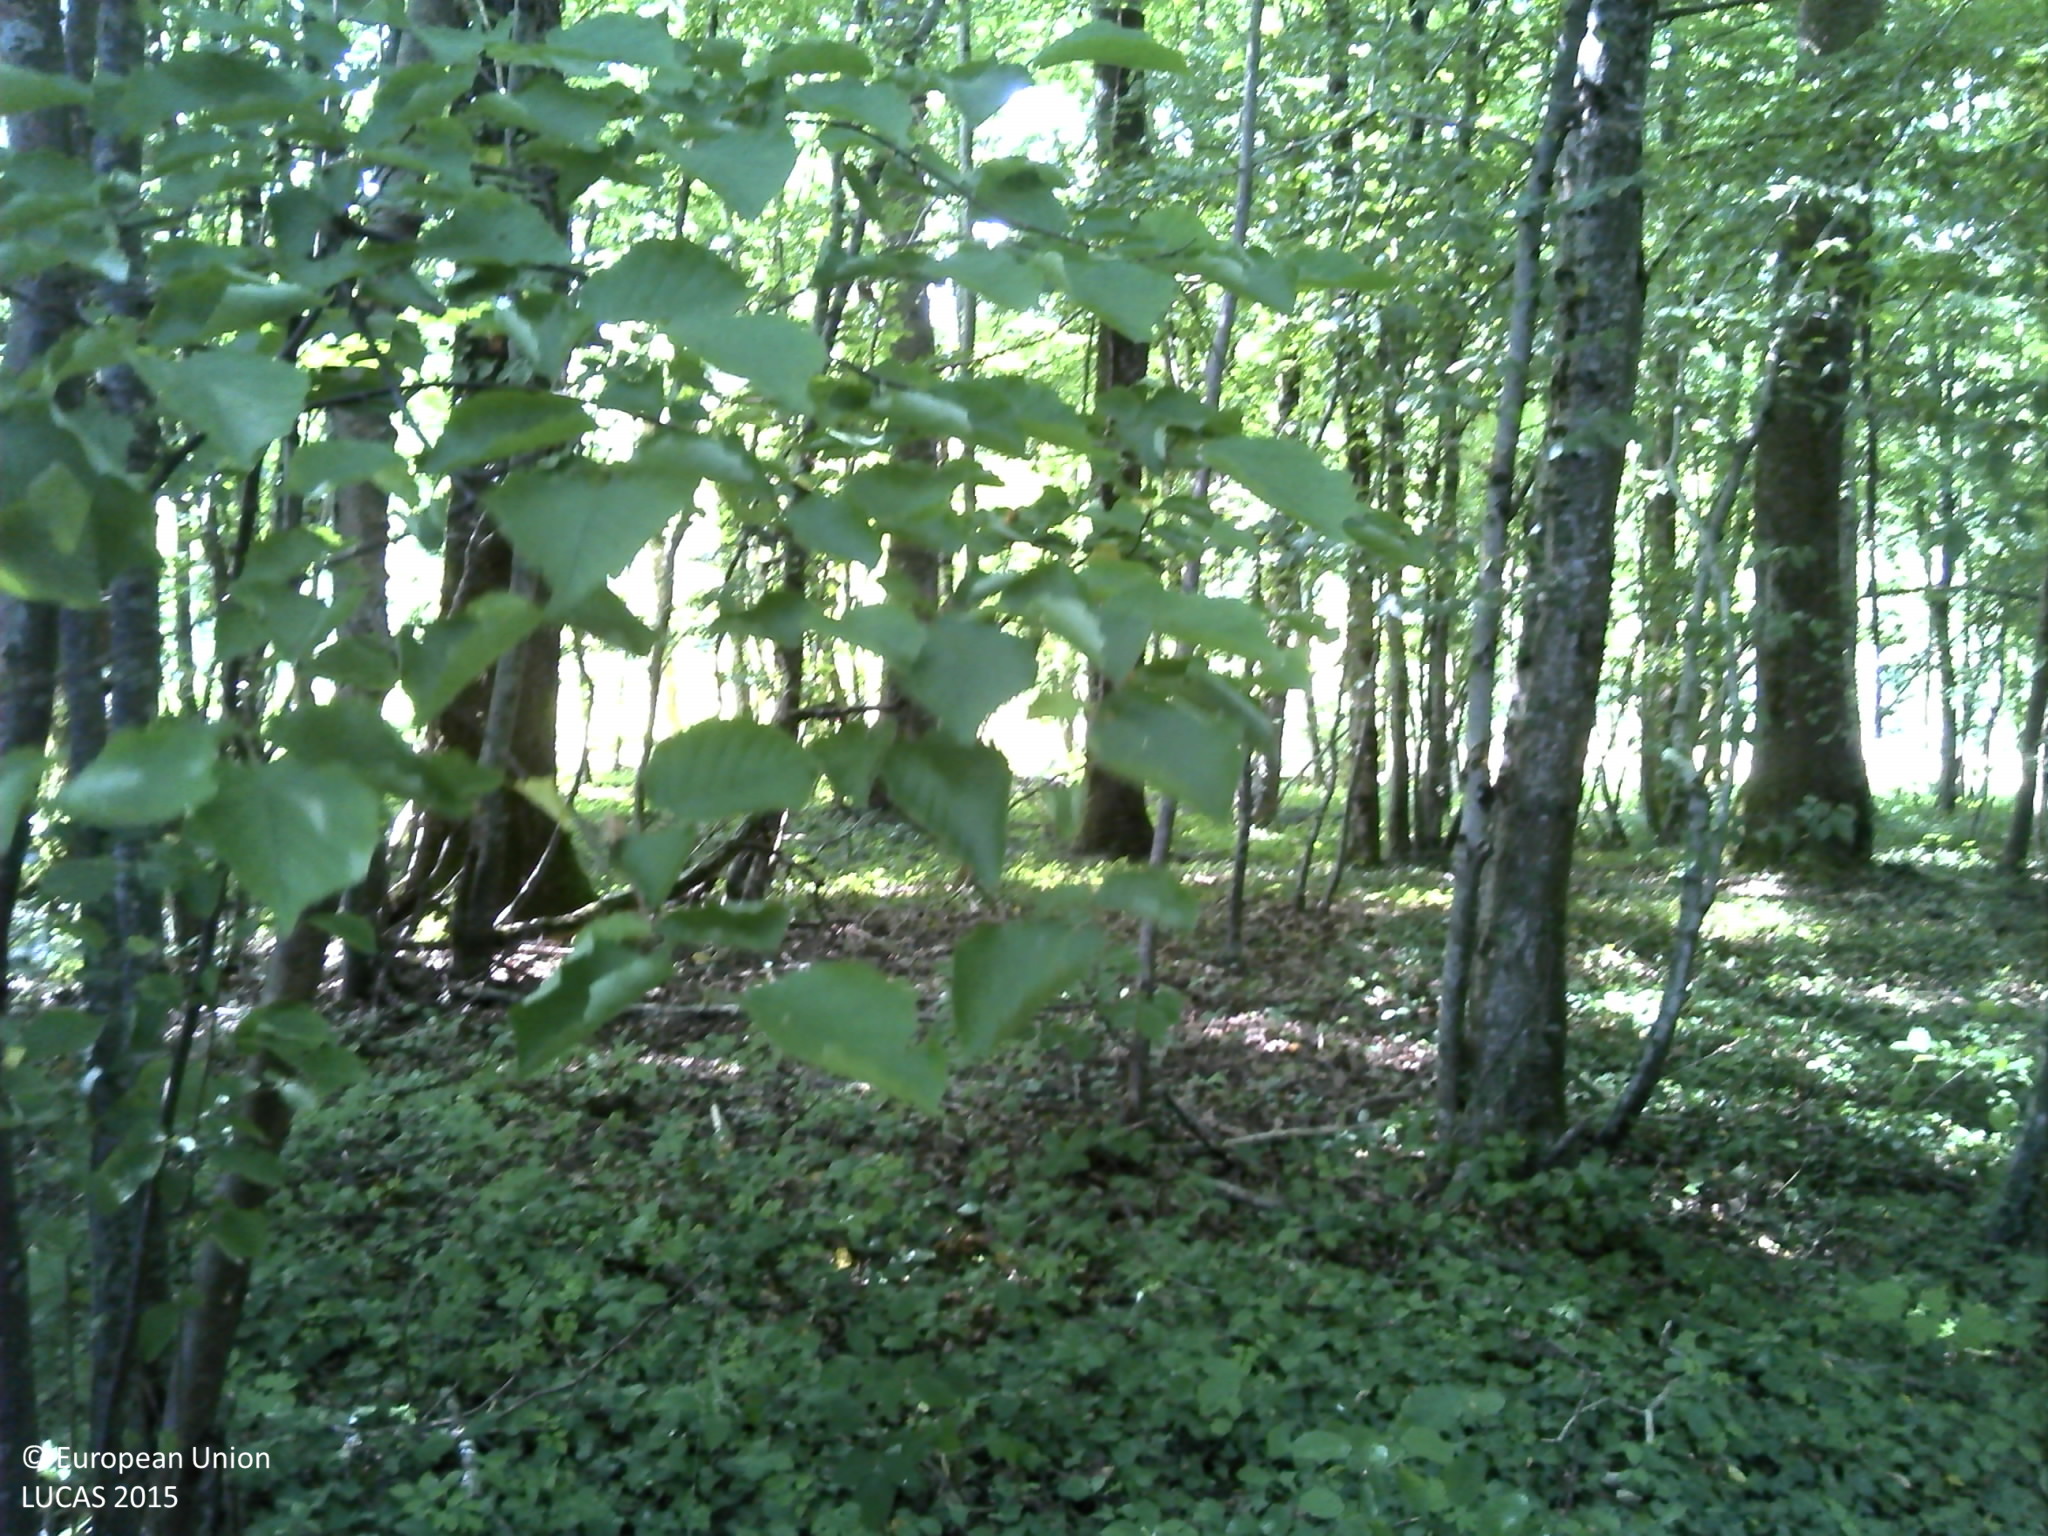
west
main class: Woodland
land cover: Broadleaved woodland
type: beech forest
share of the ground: > 75 %
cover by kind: broadleaved forest trees 90 %, coniferous forest trees 10 %
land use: Forestry
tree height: > 5 m
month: July
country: FR
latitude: 48.8800
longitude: 4.8842
